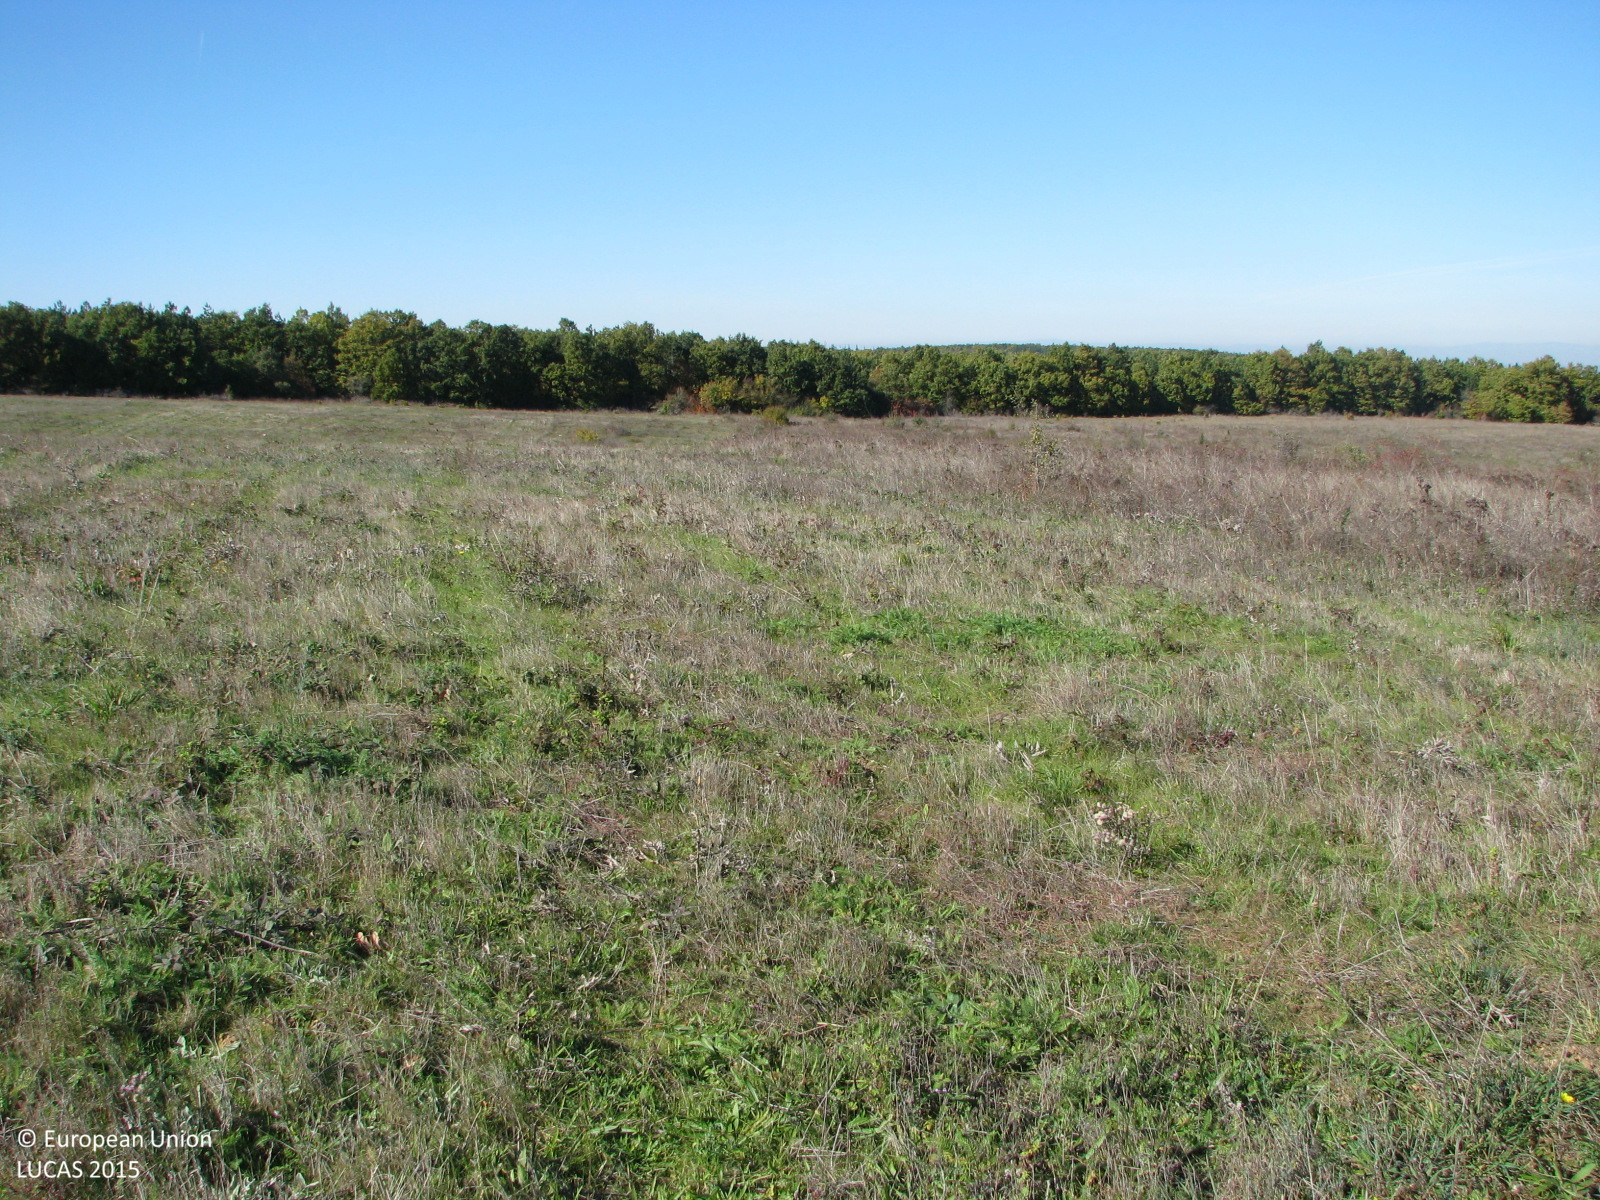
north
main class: Grassland
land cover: Grassland without tree/shrub cover
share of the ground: > 75 %
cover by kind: herbaceous plants 100 %
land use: Agriculture (excluding fallow land and kitchen gardens)
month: November
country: BG
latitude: 42.0252
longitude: 26.7221
